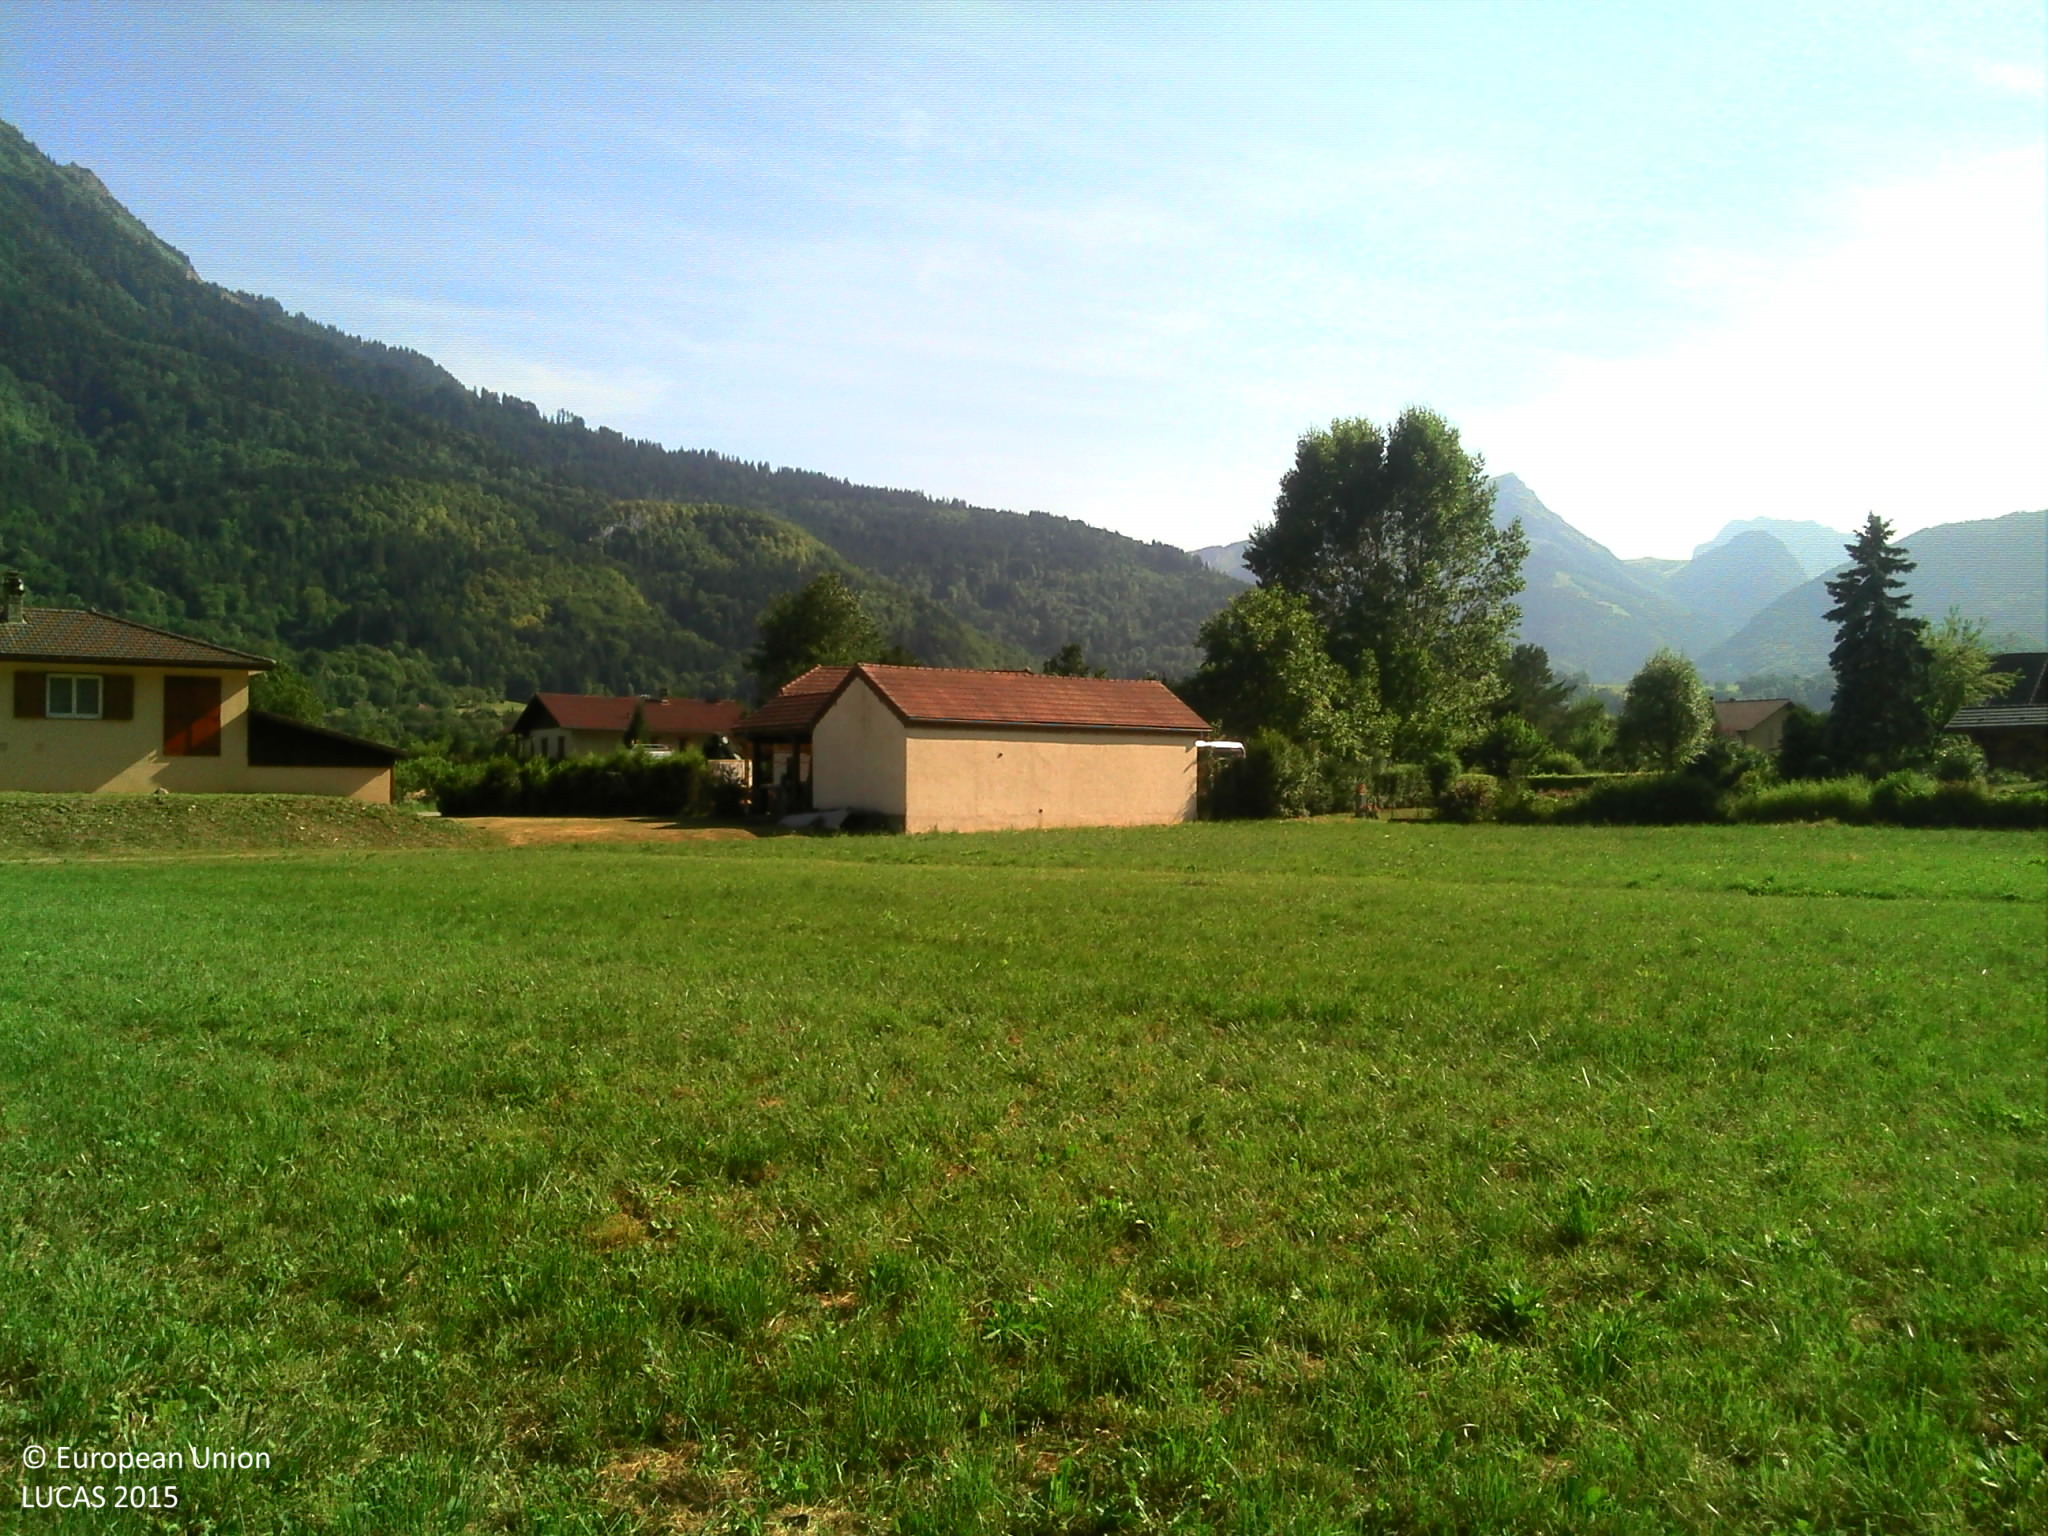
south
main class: Grassland
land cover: Grassland without tree/shrub cover
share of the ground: > 75 %
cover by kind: herbaceous plants 100 %
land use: Agriculture (excluding fallow land and kitchen gardens)
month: July
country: FR
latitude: 45.7657
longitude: 6.3396
